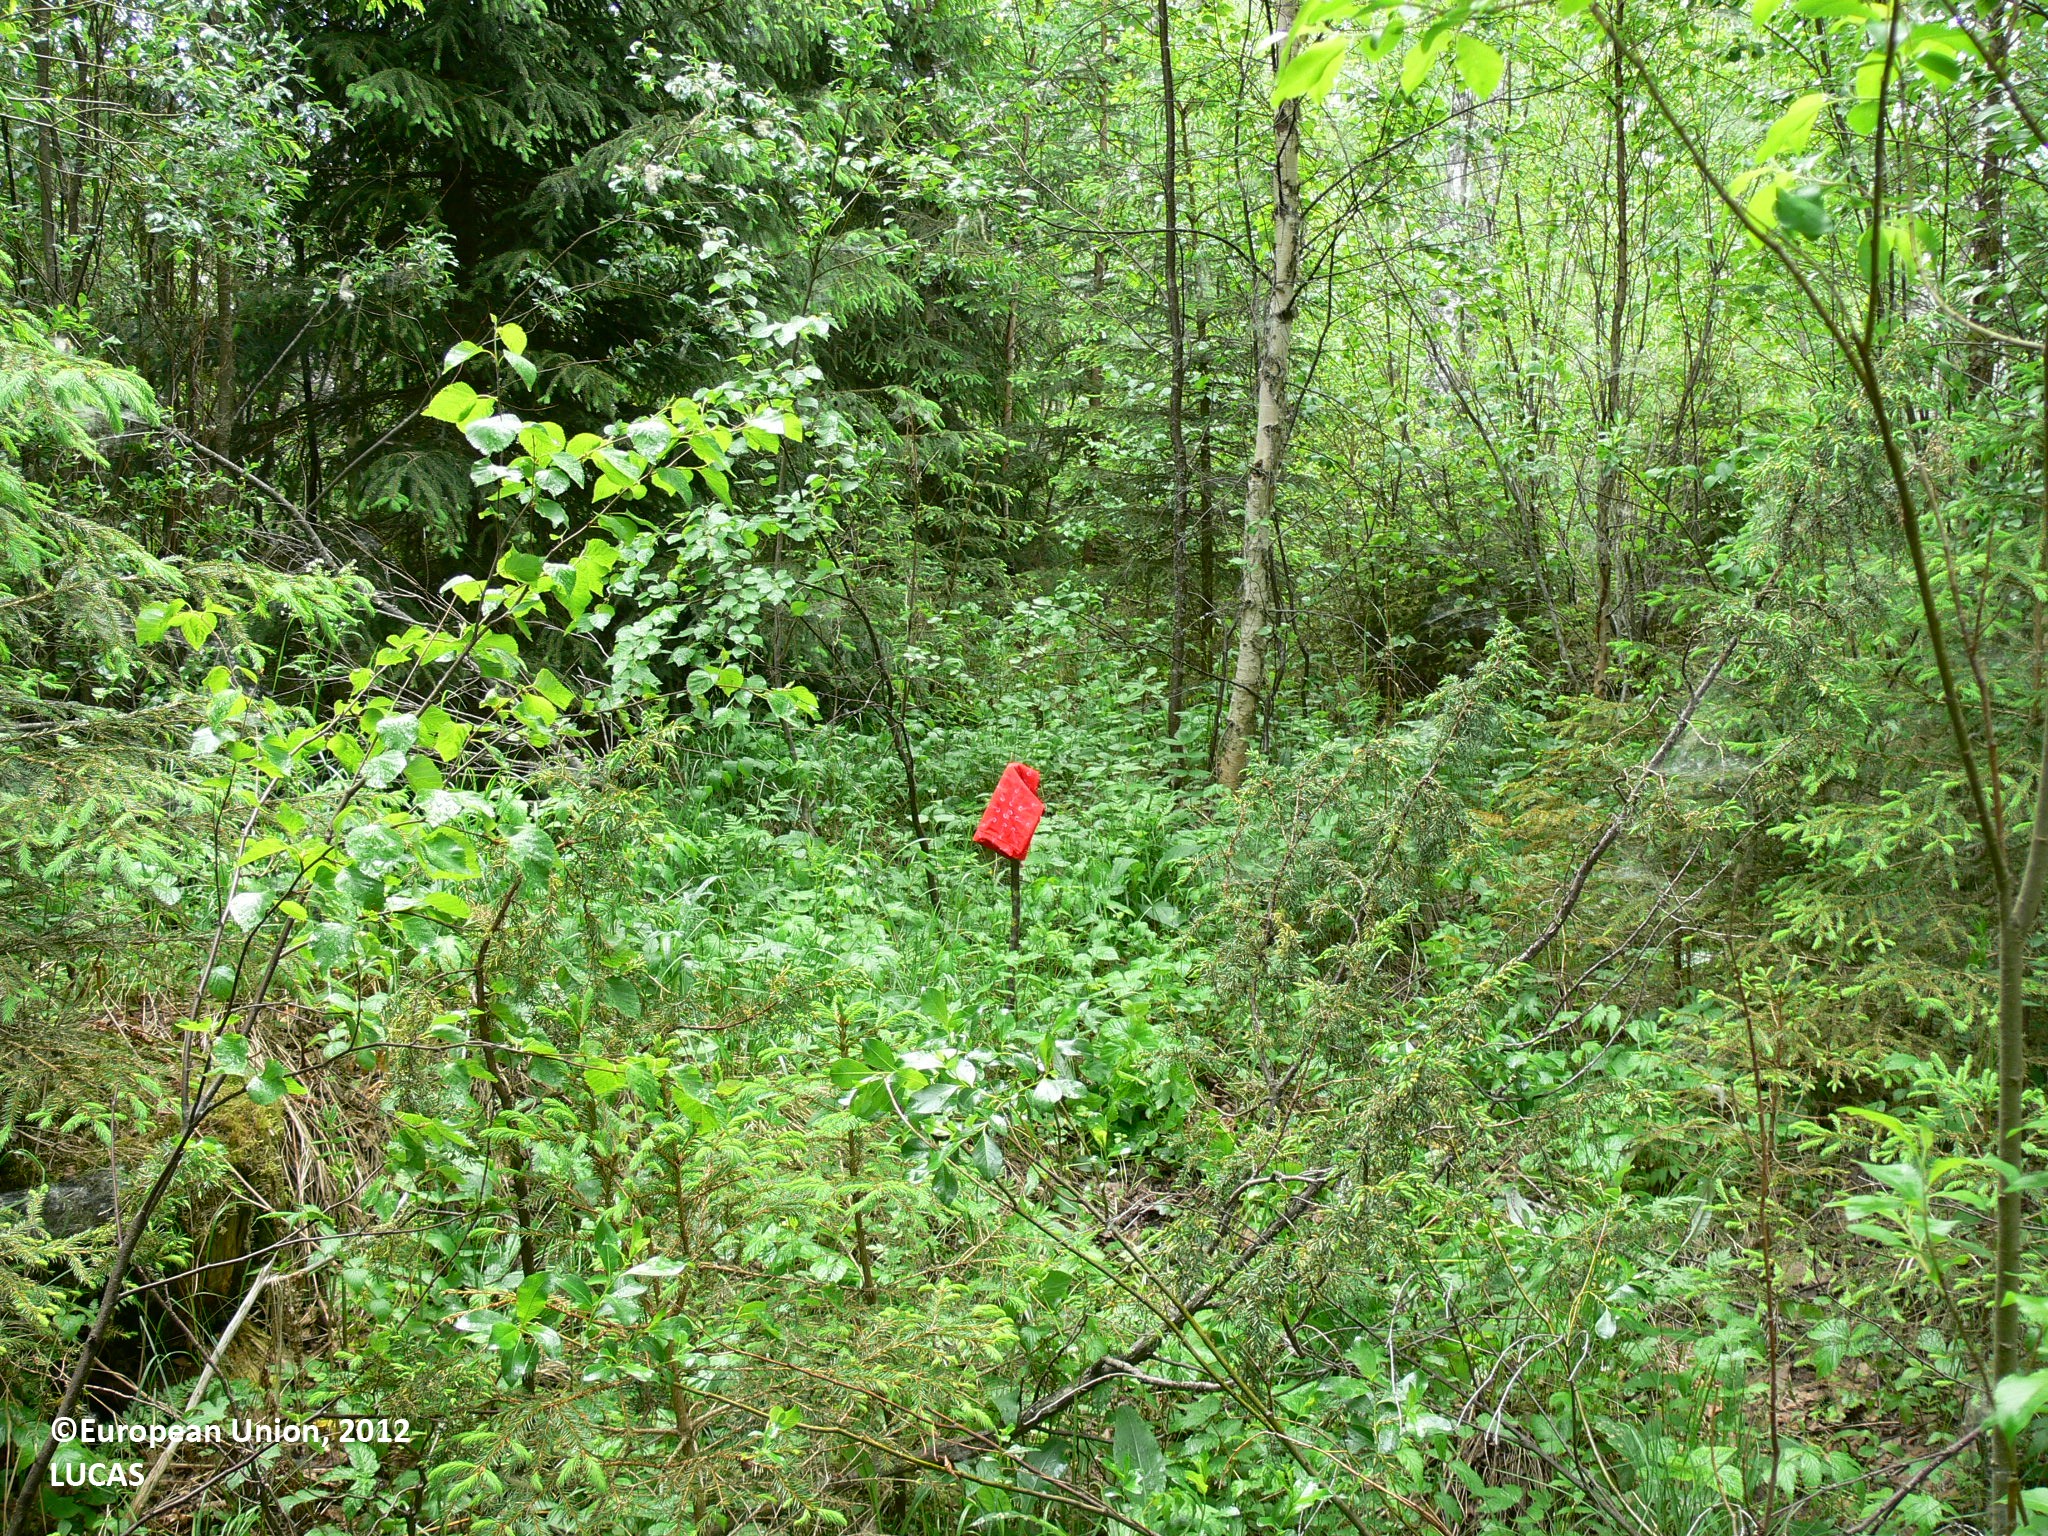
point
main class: Woodland
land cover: Spruce dominated mixed woodland
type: boreal forest
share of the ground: 50 - 75 %
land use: Forestry
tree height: > 5 m
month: June
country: FI
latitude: 62.7815
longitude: 29.8684
